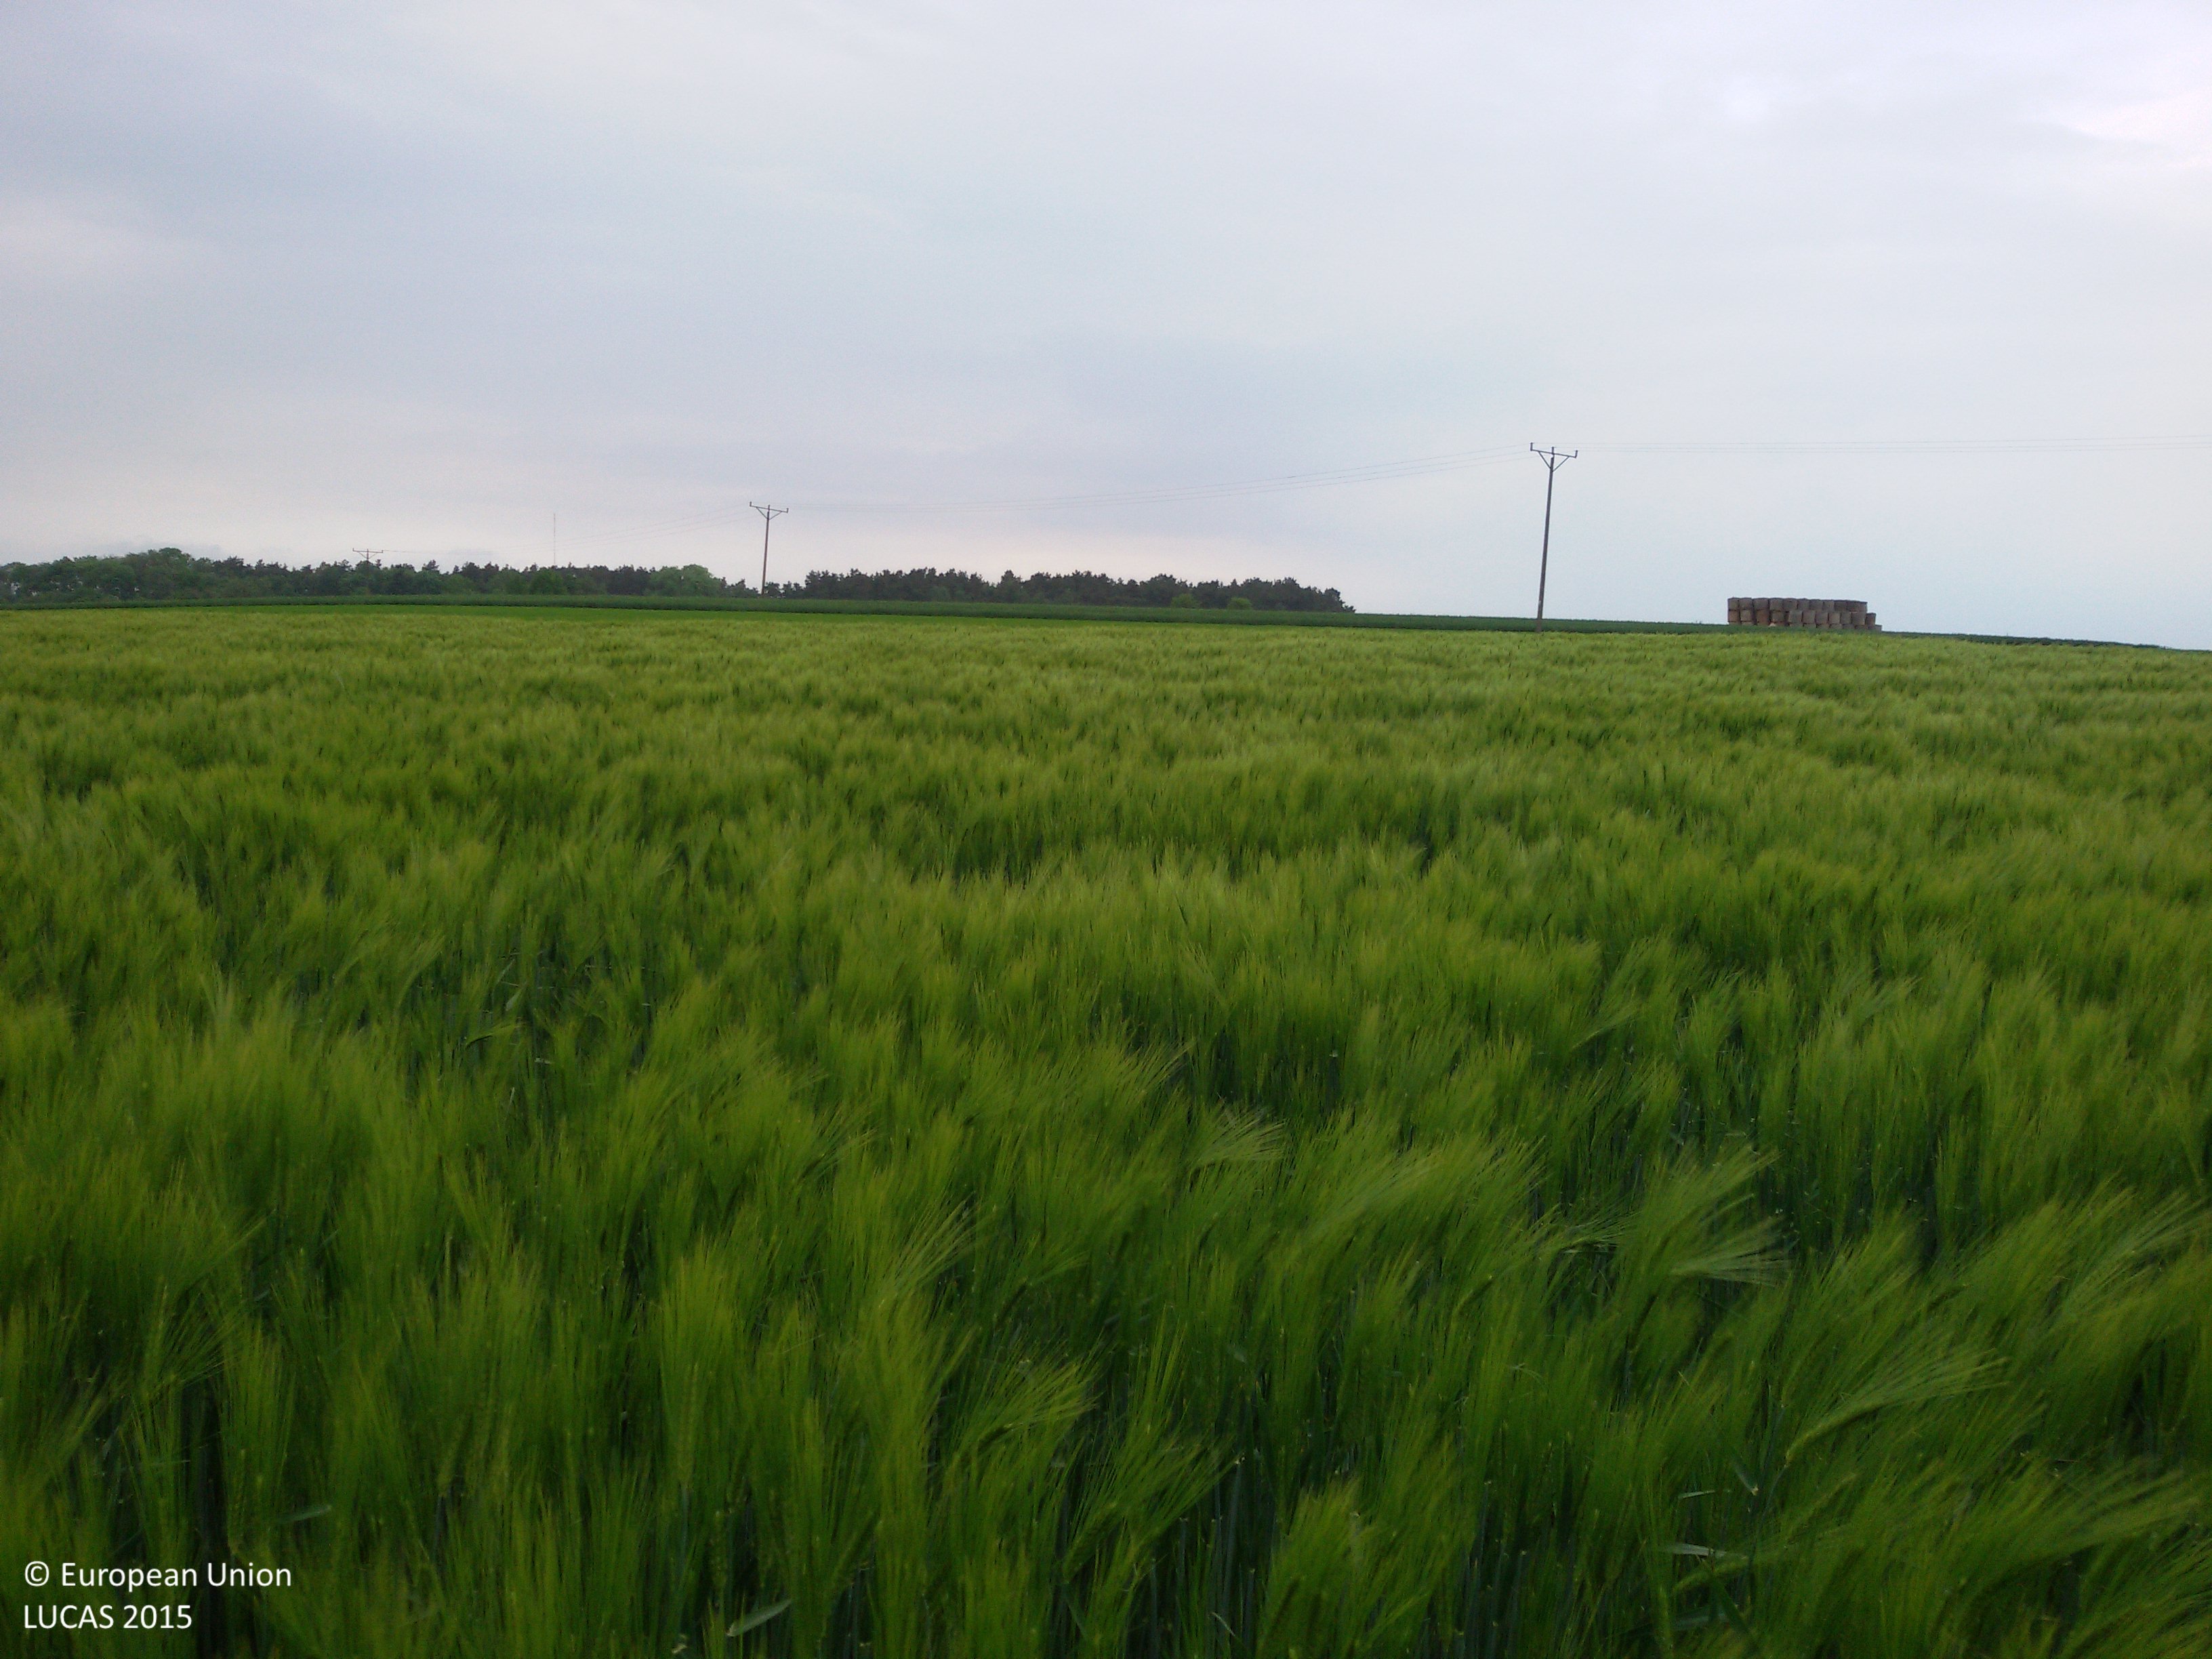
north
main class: Cropland
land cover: Barley
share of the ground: > 75 %
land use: Agriculture (excluding fallow land and kitchen gardens)
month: May
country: PL
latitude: 53.1853
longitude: 17.2385
